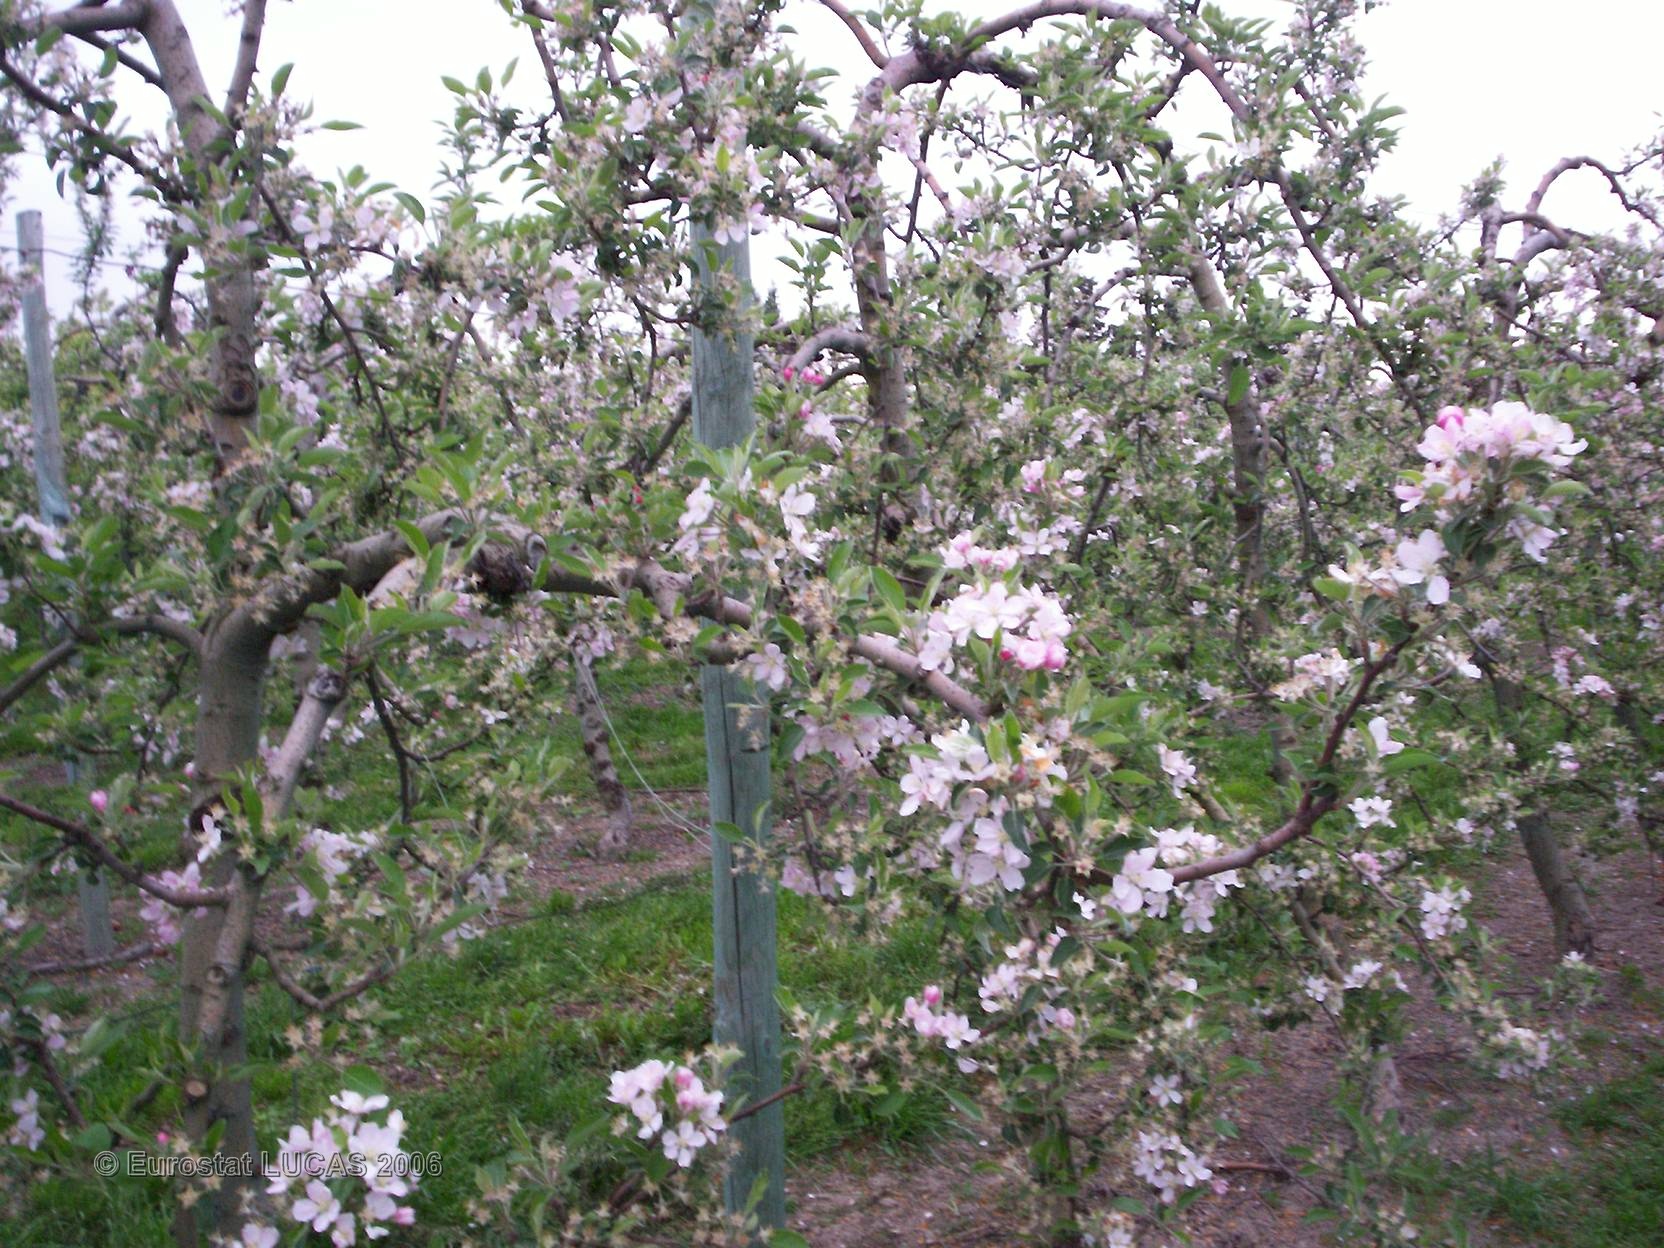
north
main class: Cropland
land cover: Apple fruit
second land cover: Grassland with sparse tree/shrub cover
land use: Agriculture (excluding fallow land and kitchen gardens)
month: April
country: FR
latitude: 43.8647
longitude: 4.9198
